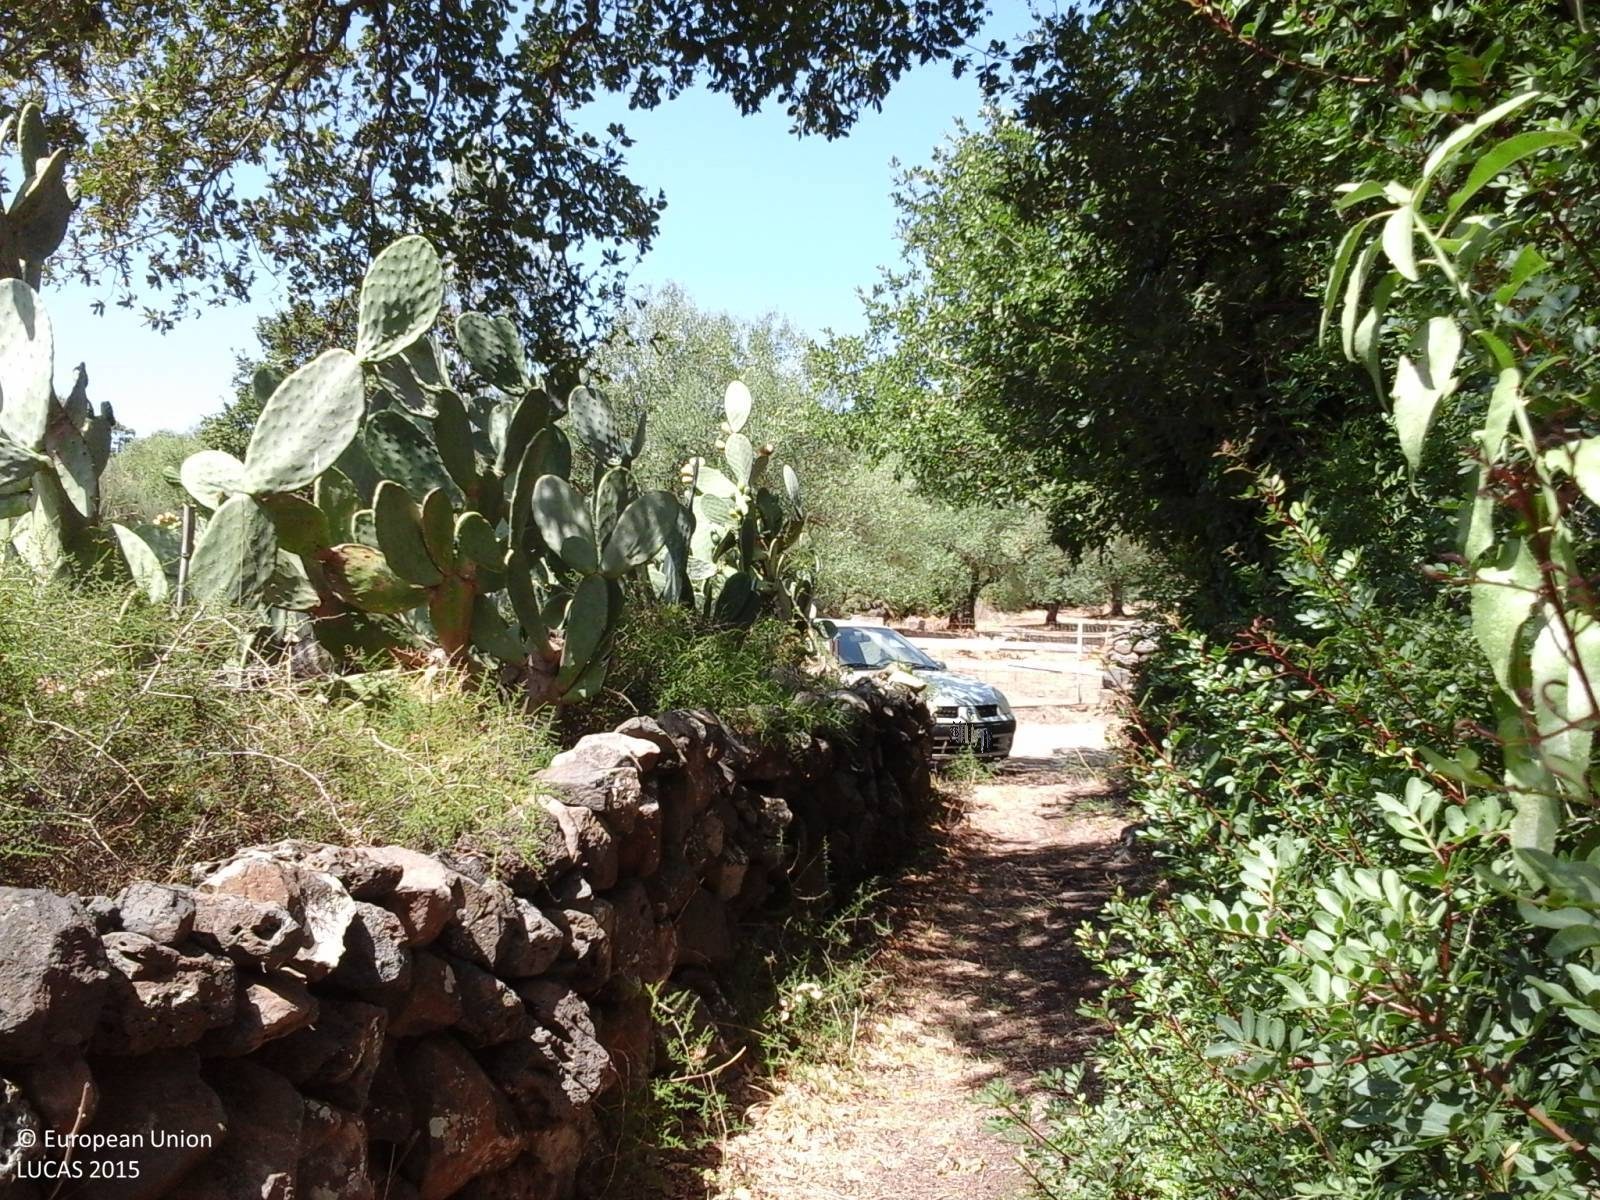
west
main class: Cropland
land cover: Olive groves
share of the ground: > 75 %
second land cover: Grassland without tree/shrub cover
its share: > 75 %
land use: Agriculture (excluding fallow land and kitchen gardens)
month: August
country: IT
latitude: 40.1162
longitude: 8.8913
